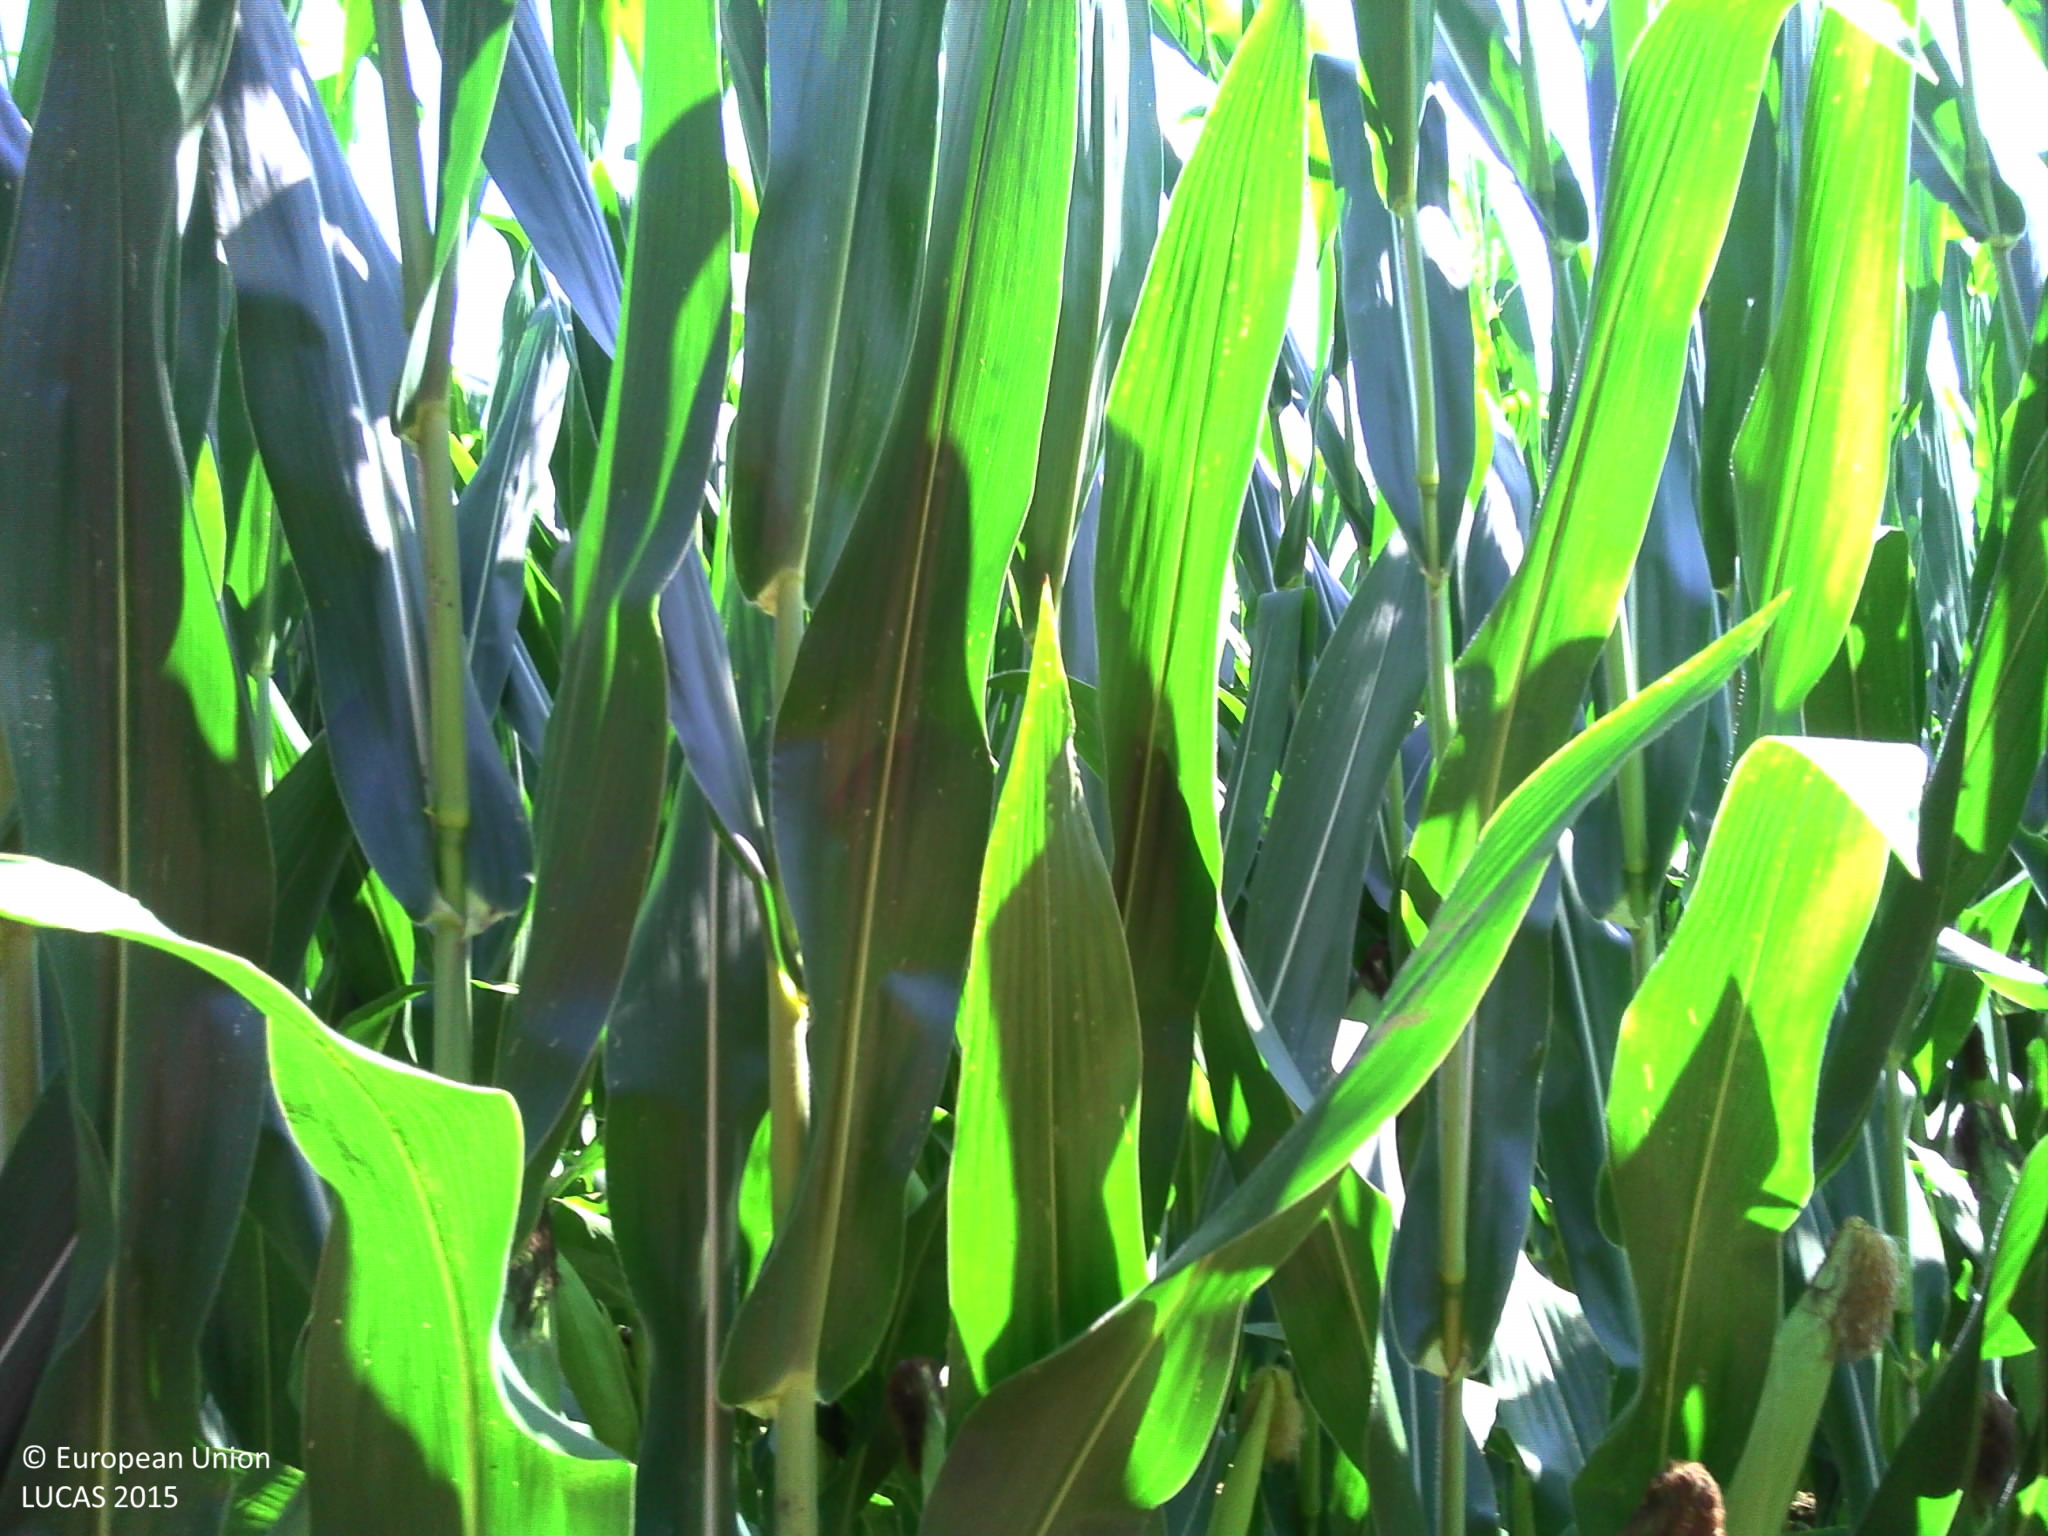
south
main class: Cropland
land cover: Maize
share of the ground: > 75 %
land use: Agriculture (excluding fallow land and kitchen gardens)
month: August
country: FR
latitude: 43.7000
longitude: -0.7461
